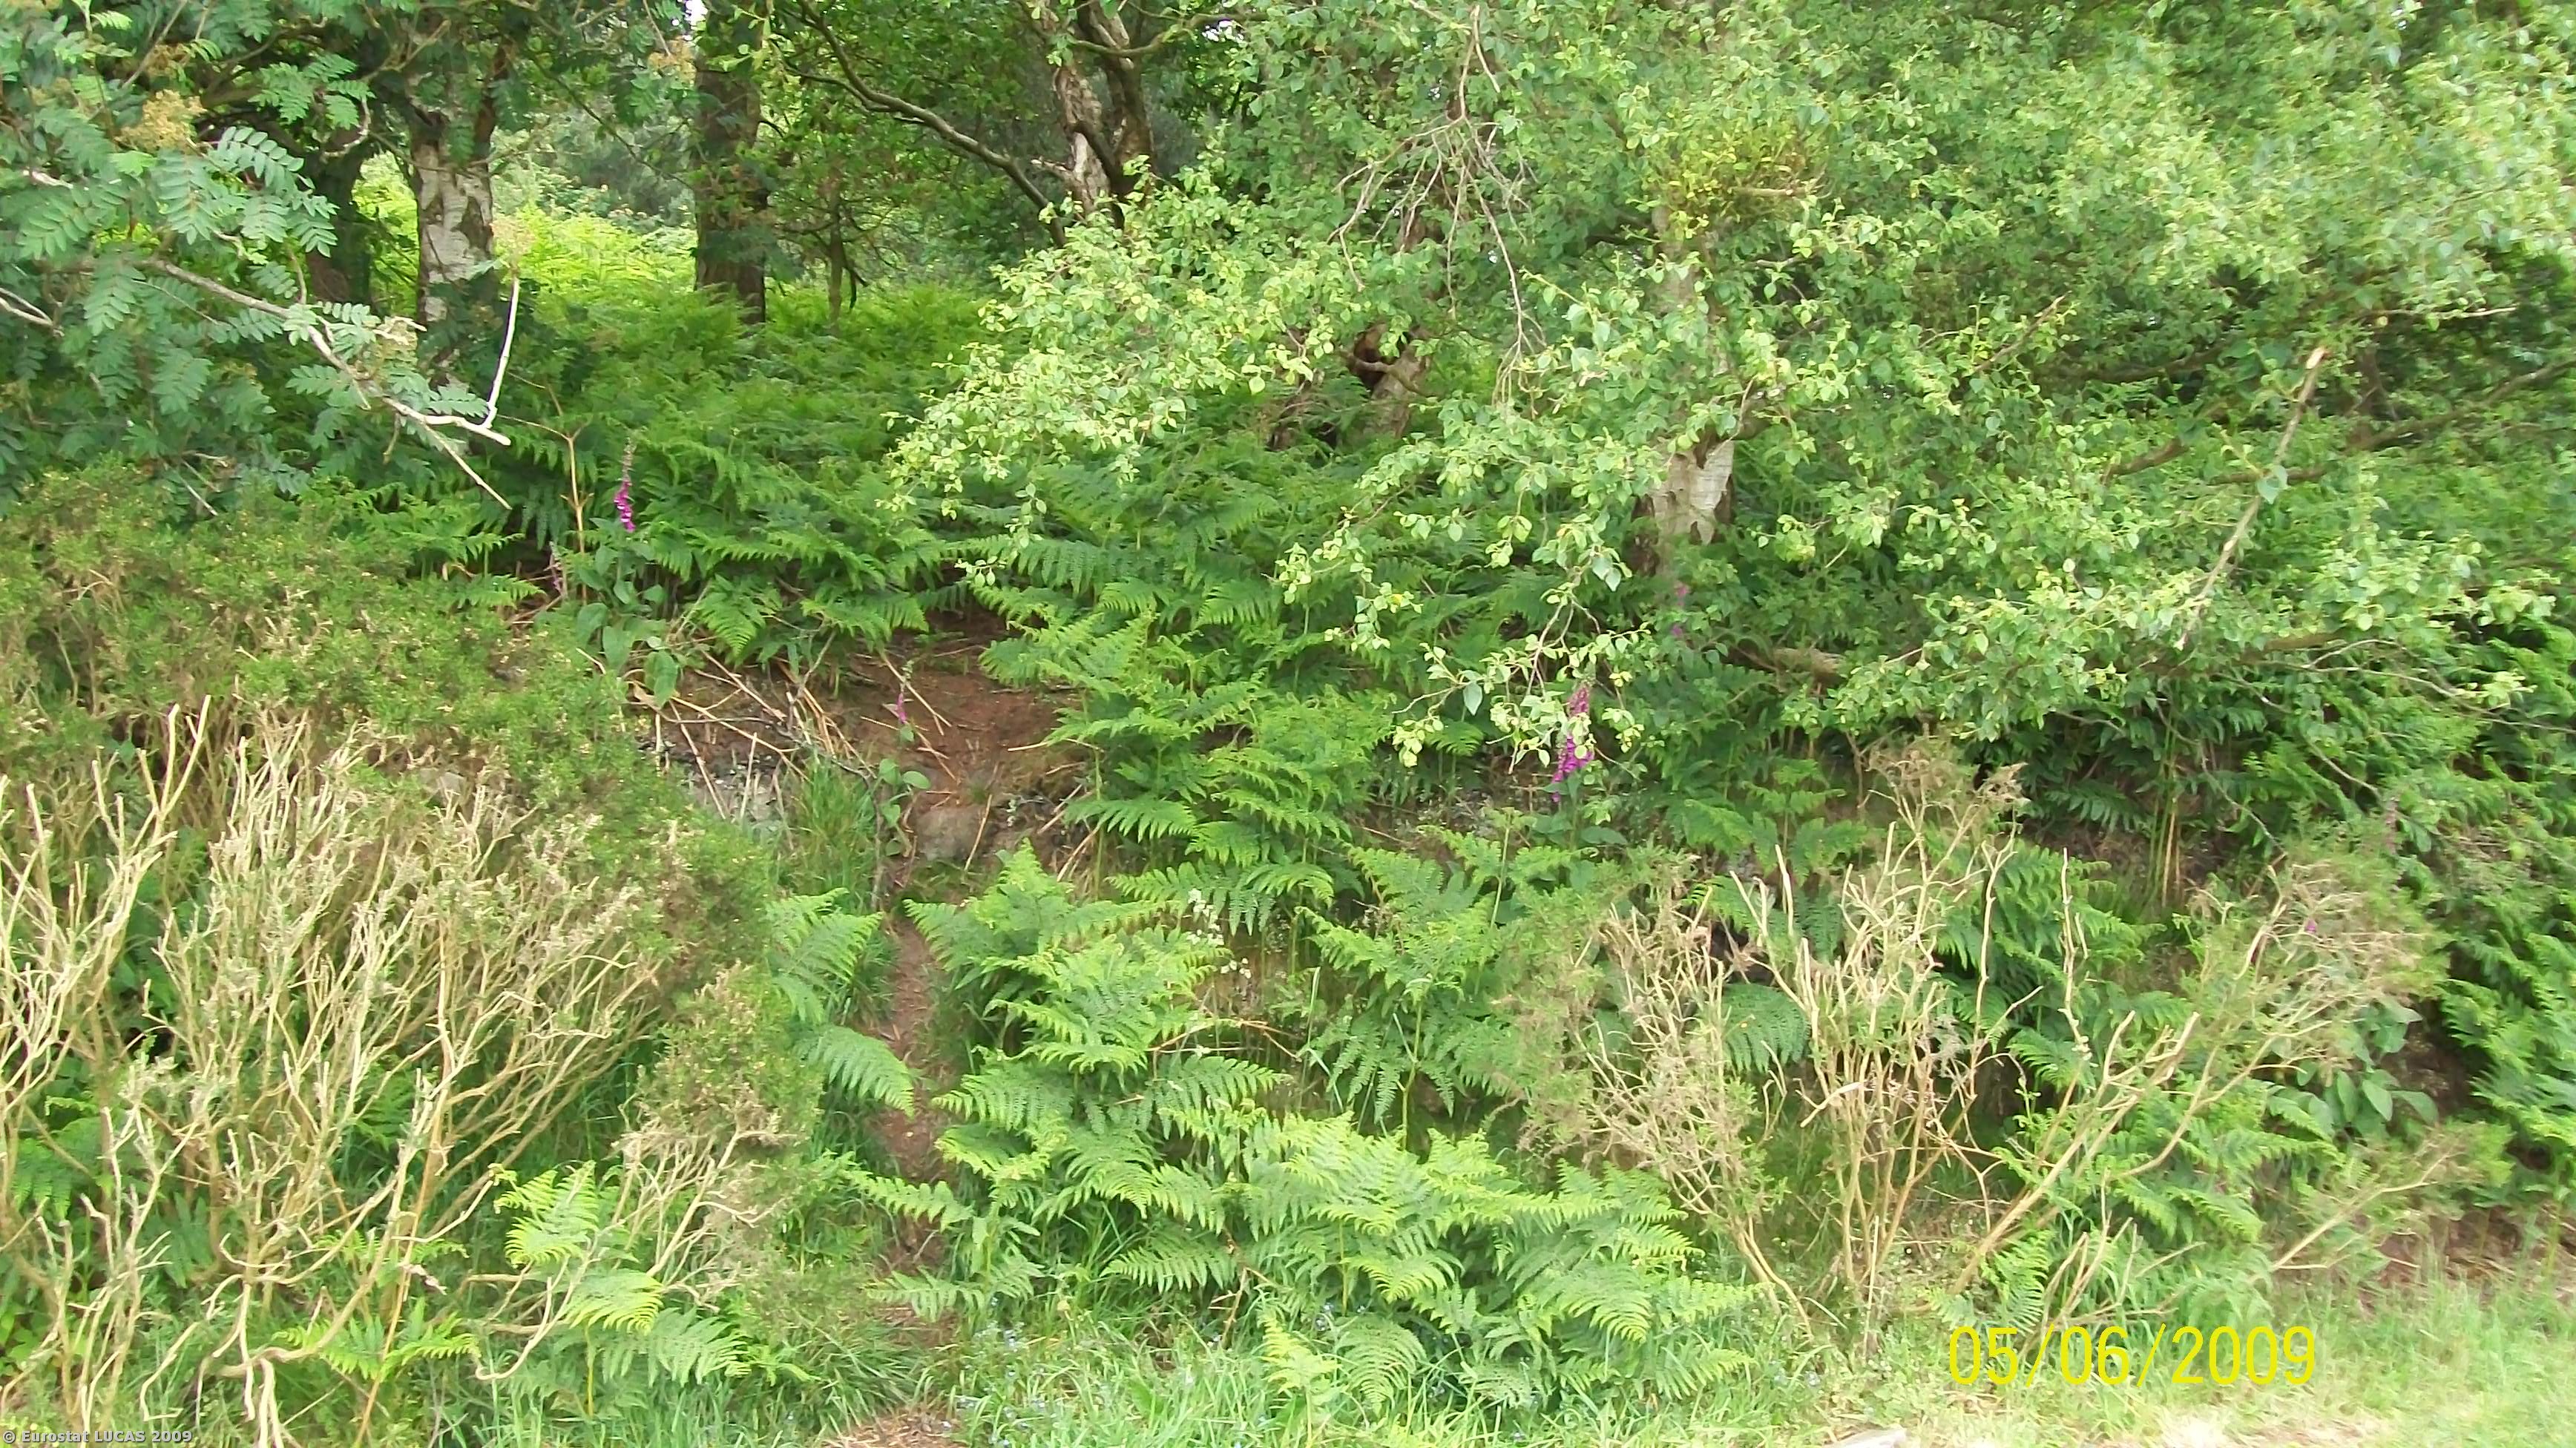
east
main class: Grassland
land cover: Grassland without tree/shrub cover
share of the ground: > 75 %
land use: Agriculture (excluding fallow land and kitchen gardens)
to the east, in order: Grassland without tree/shrub cover; Grass margins; Fences; Grass margins; Tracks; Grass margins; Broadleaved woodland; Artificial constructions in urban areas; Grassland without tree/shrub cover; Broadleaved woodland
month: June
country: GB
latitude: 53.0922
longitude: -2.7174
